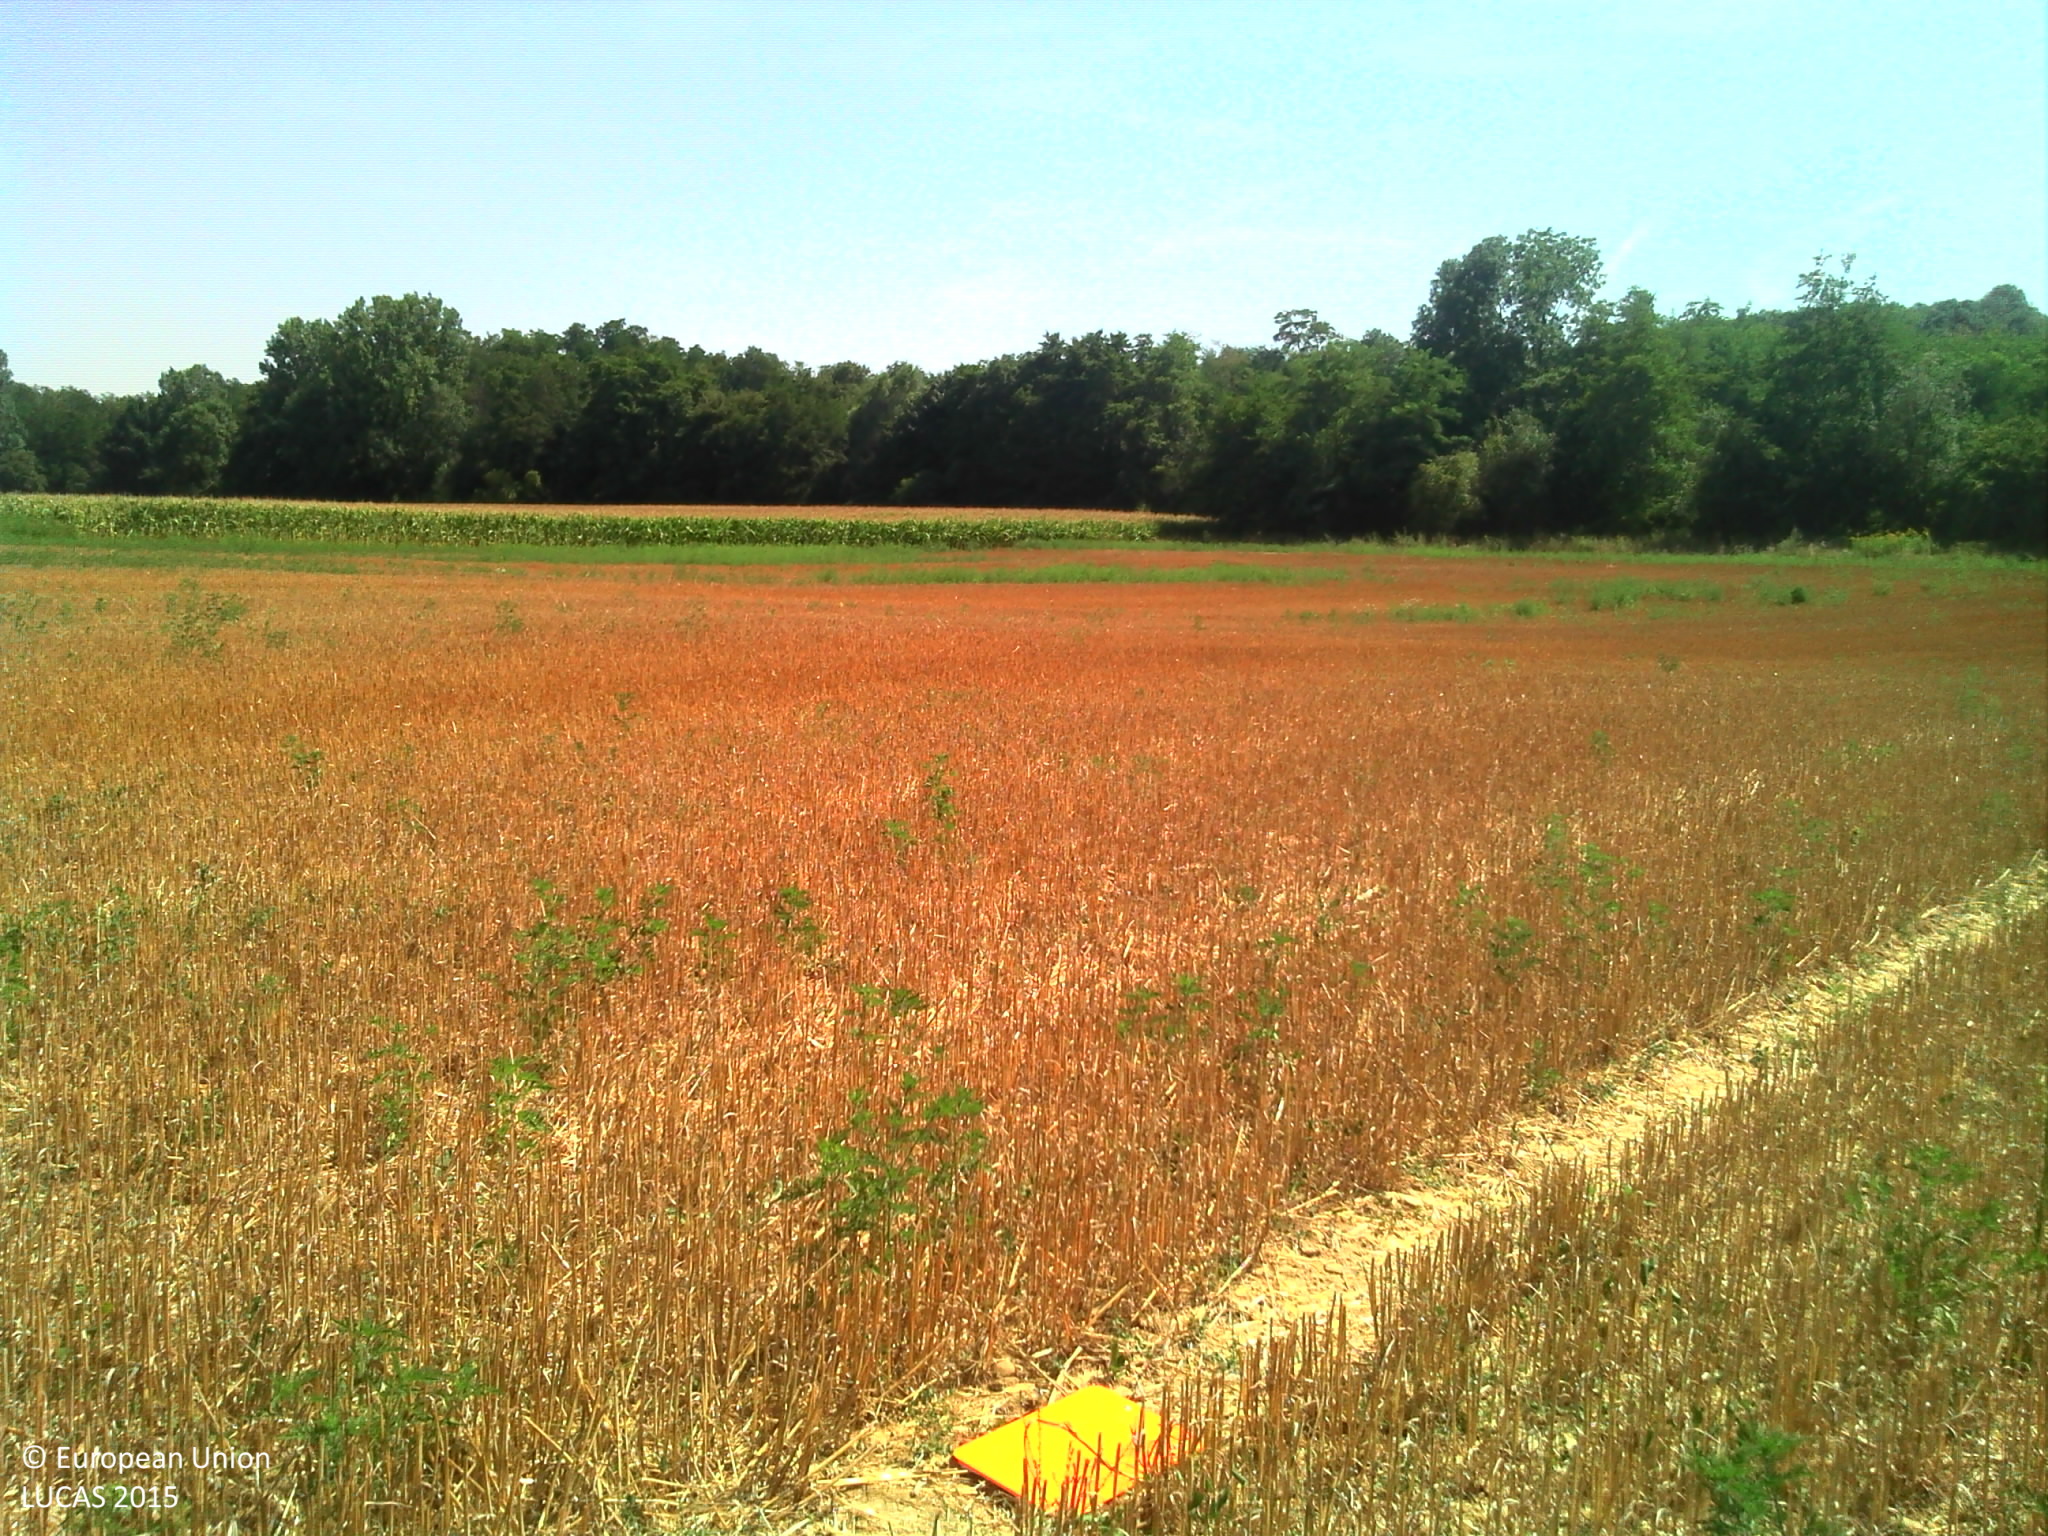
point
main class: Cropland
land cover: Durum wheat
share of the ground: > 75 %
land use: Agriculture (excluding fallow land and kitchen gardens)
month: August
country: FR
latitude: 45.6369
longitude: 4.9623
